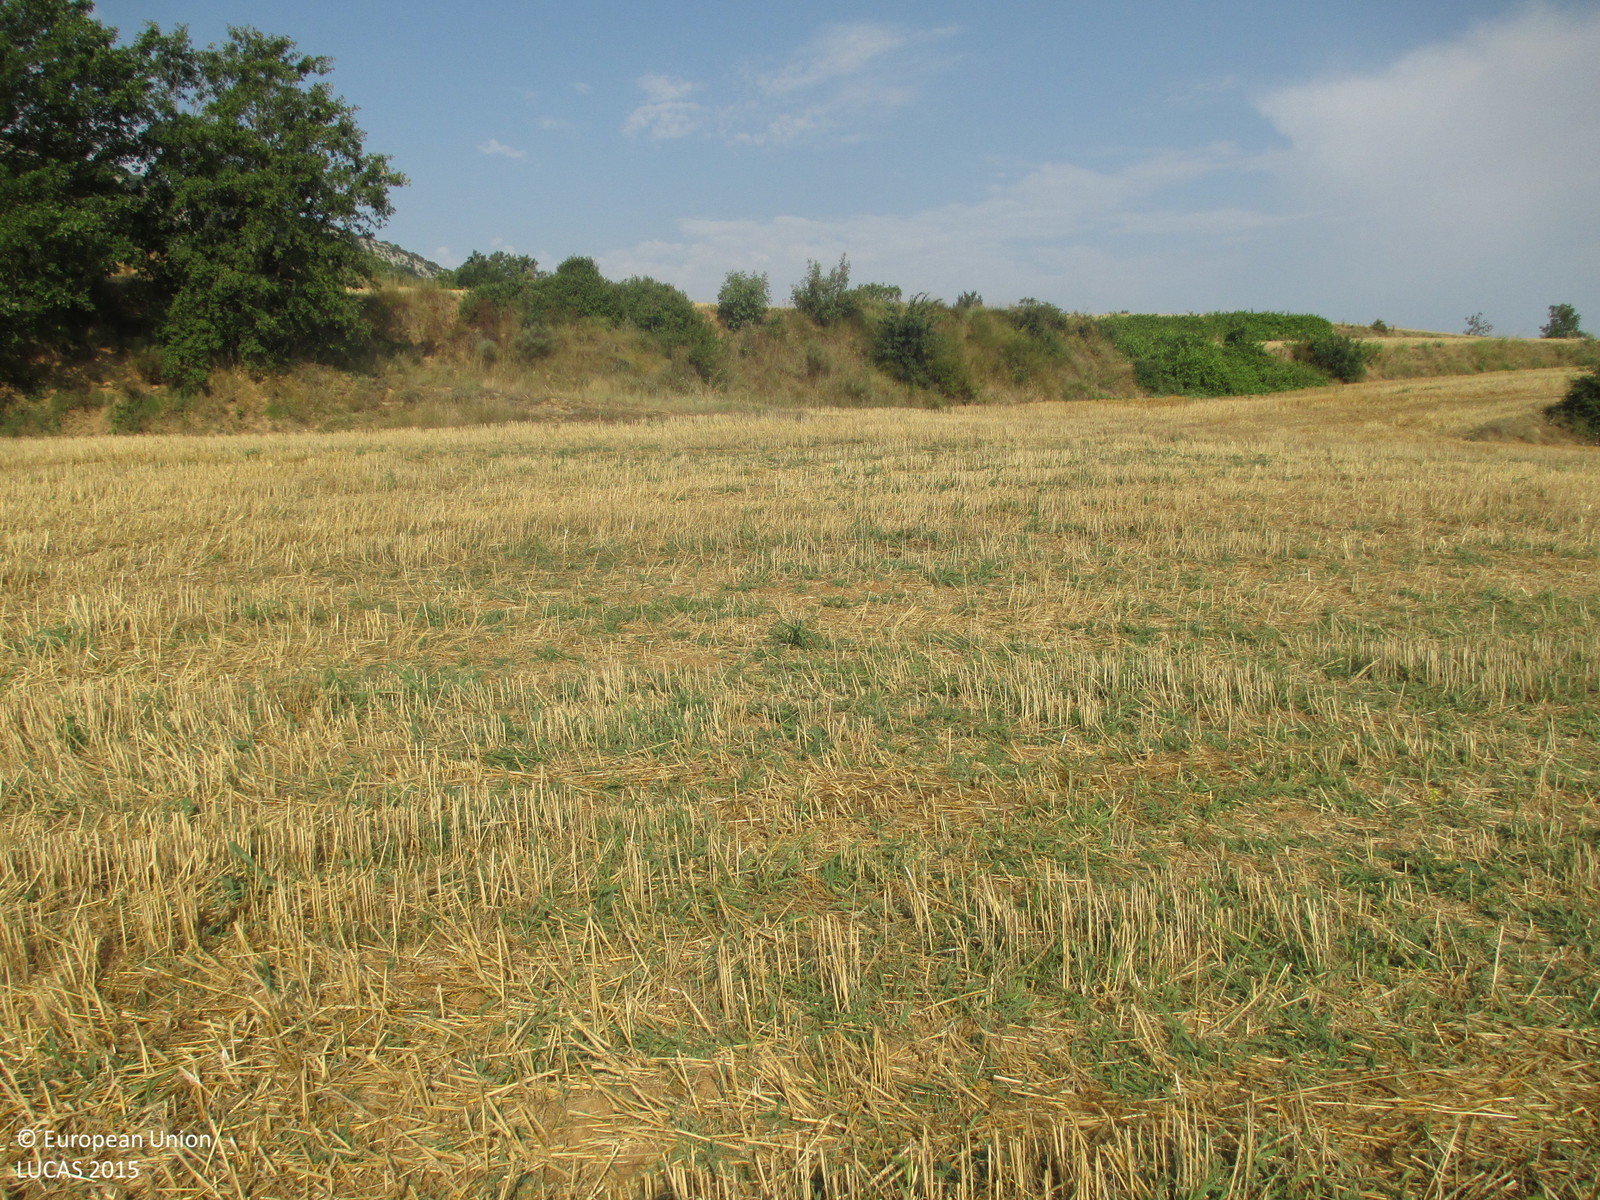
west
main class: Cropland
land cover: Common wheat
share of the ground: < 10 %
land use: Agriculture (excluding fallow land and kitchen gardens)
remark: Harvested field
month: July
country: ES
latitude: 42.1188
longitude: 0.3424
